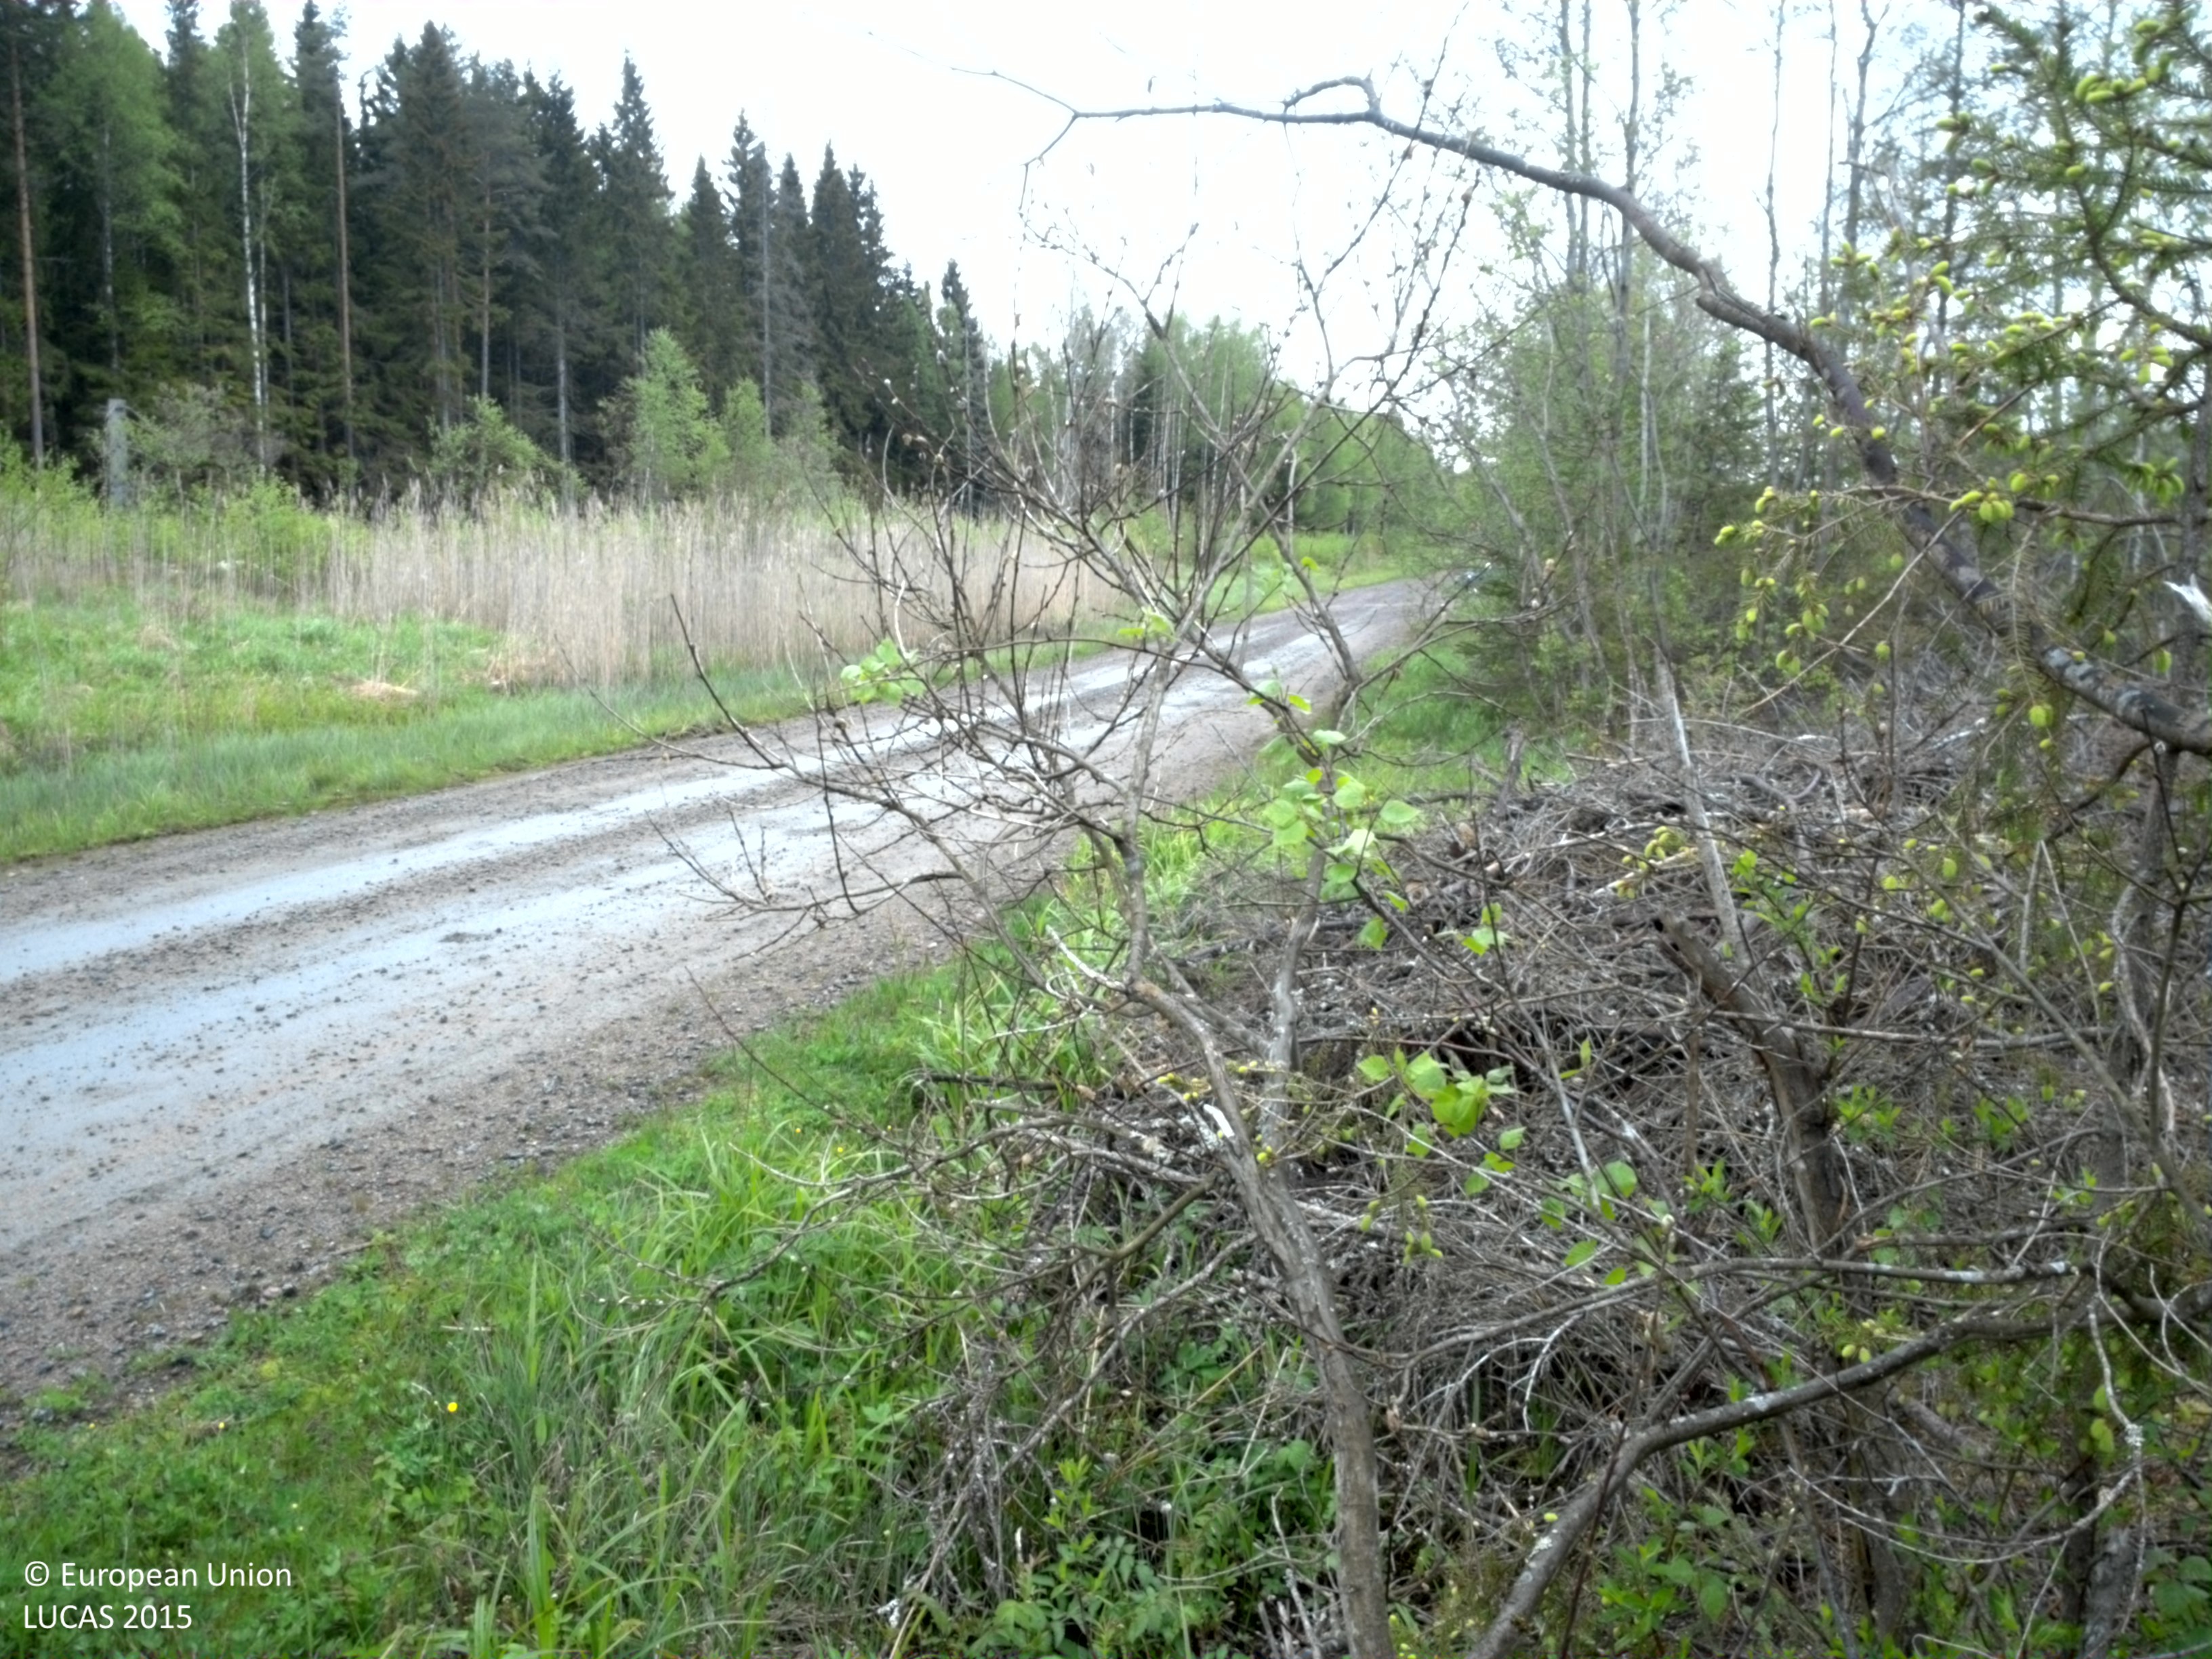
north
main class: Woodland
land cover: Broadleaved woodland
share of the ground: 25 - 50 %
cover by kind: herbaceous plants 40 %, broadleaved forest trees 35 %, lichens and mosses 15 %, coniferous forest trees 5 %, shrubs 5 %
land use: Forestry
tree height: > 5 m
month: May
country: SE
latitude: 59.3623
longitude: 14.1610
